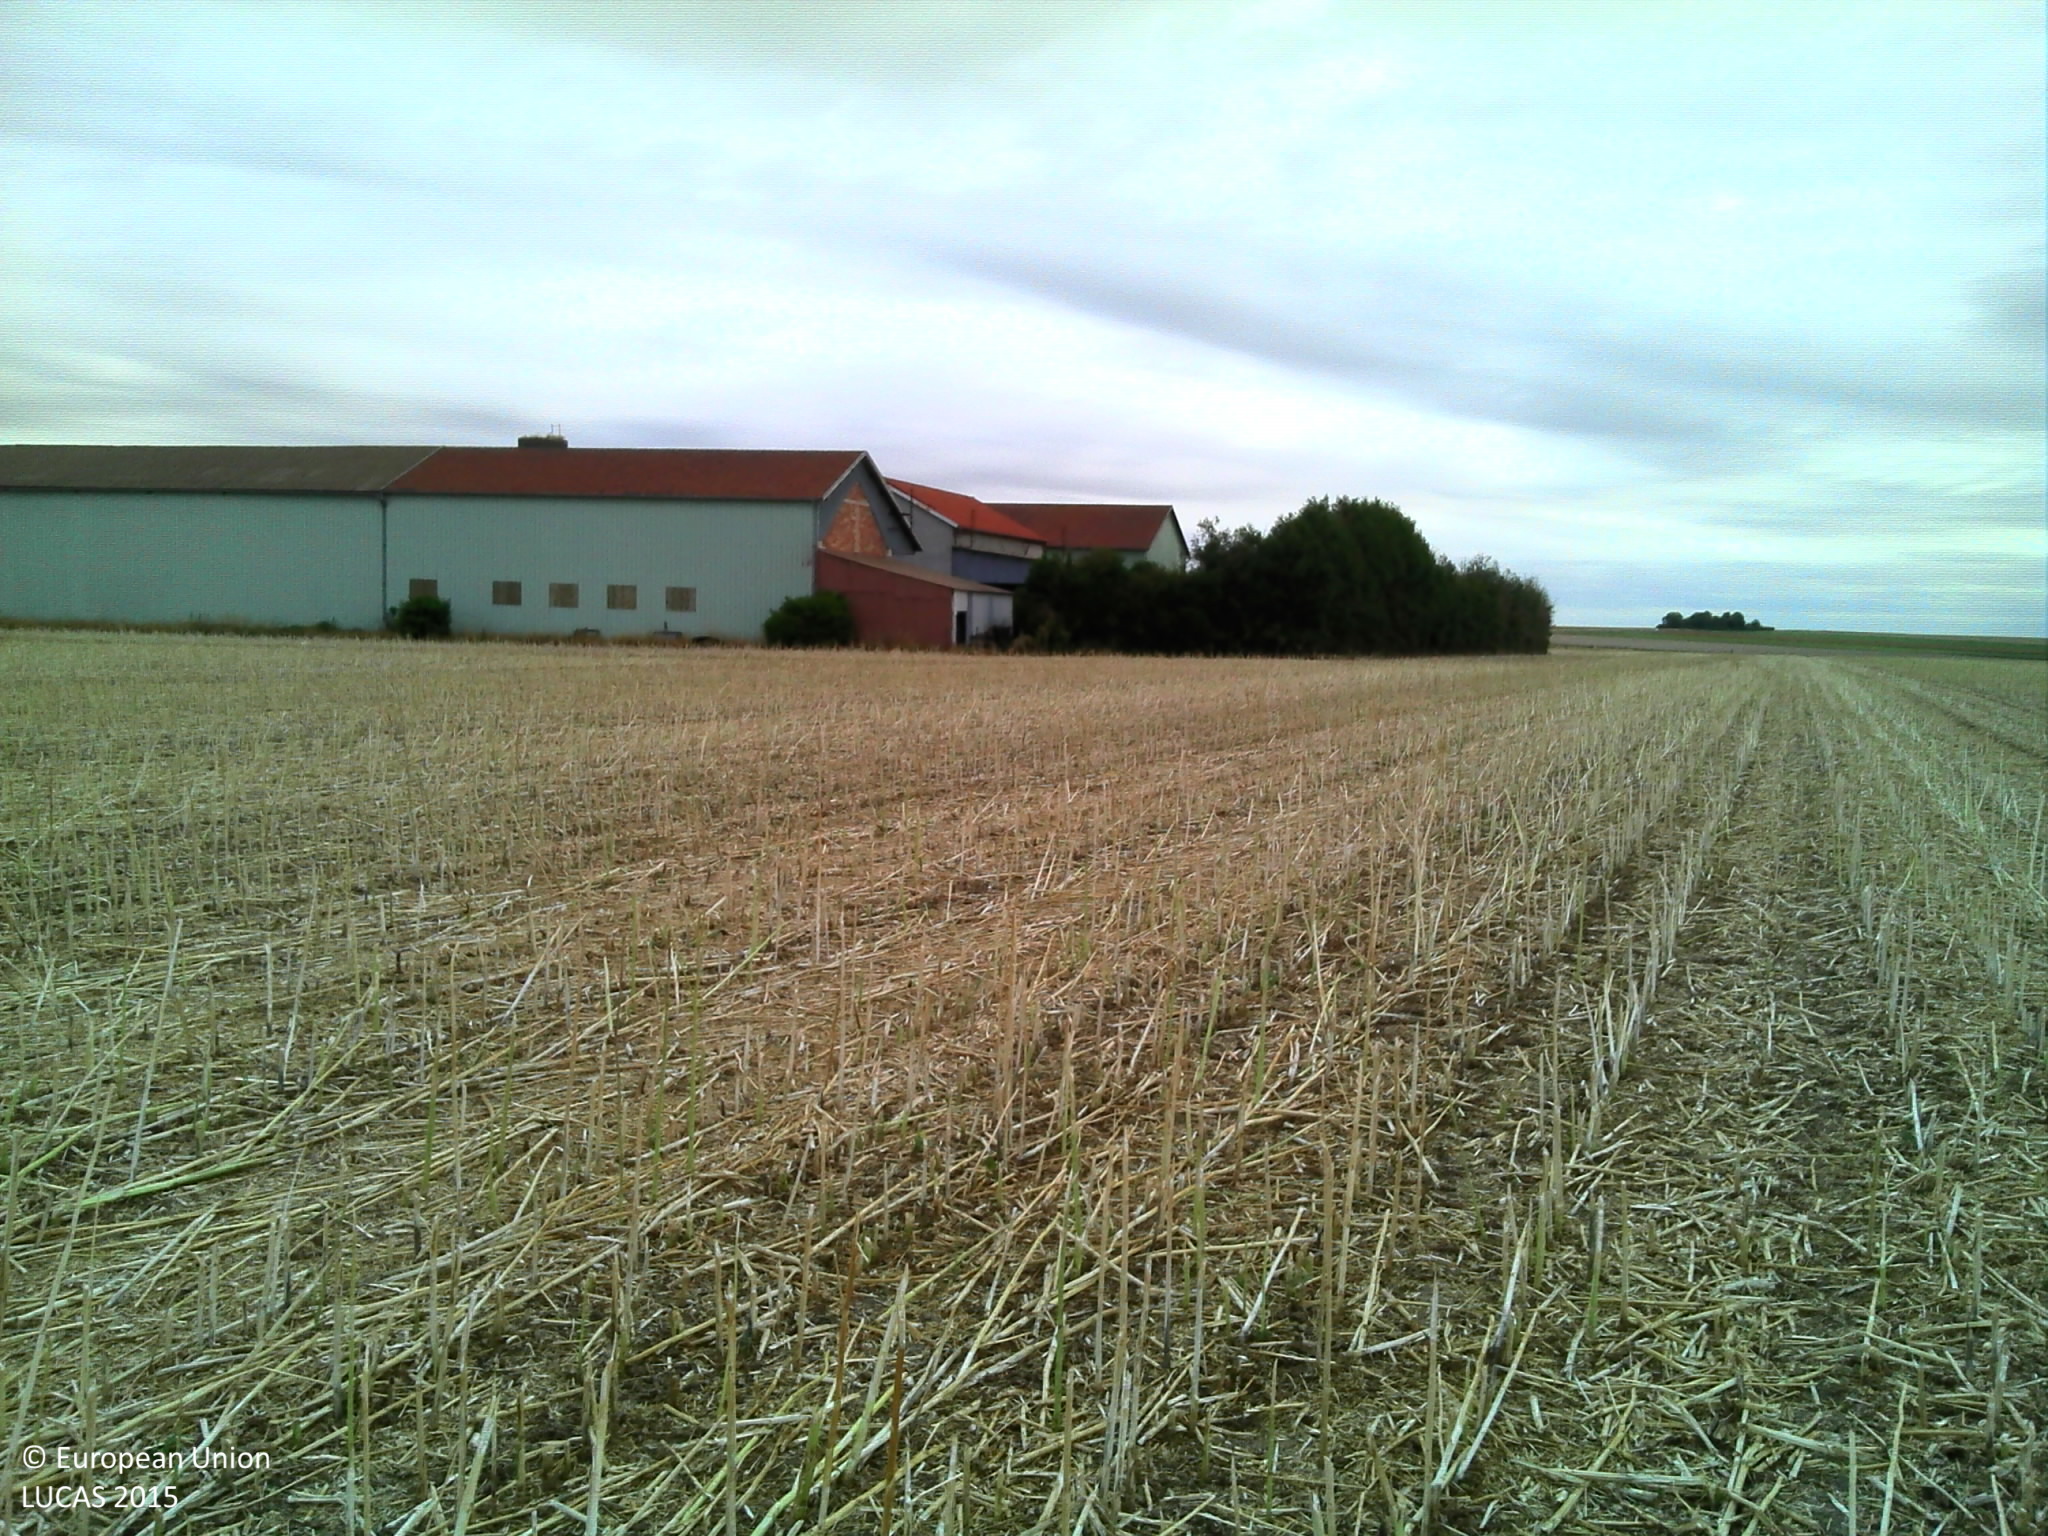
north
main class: Cropland
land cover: Rape and turnip rape
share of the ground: > 75 %
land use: Agriculture (excluding fallow land and kitchen gardens)
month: July
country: FR
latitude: 49.3084
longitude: 4.0670
